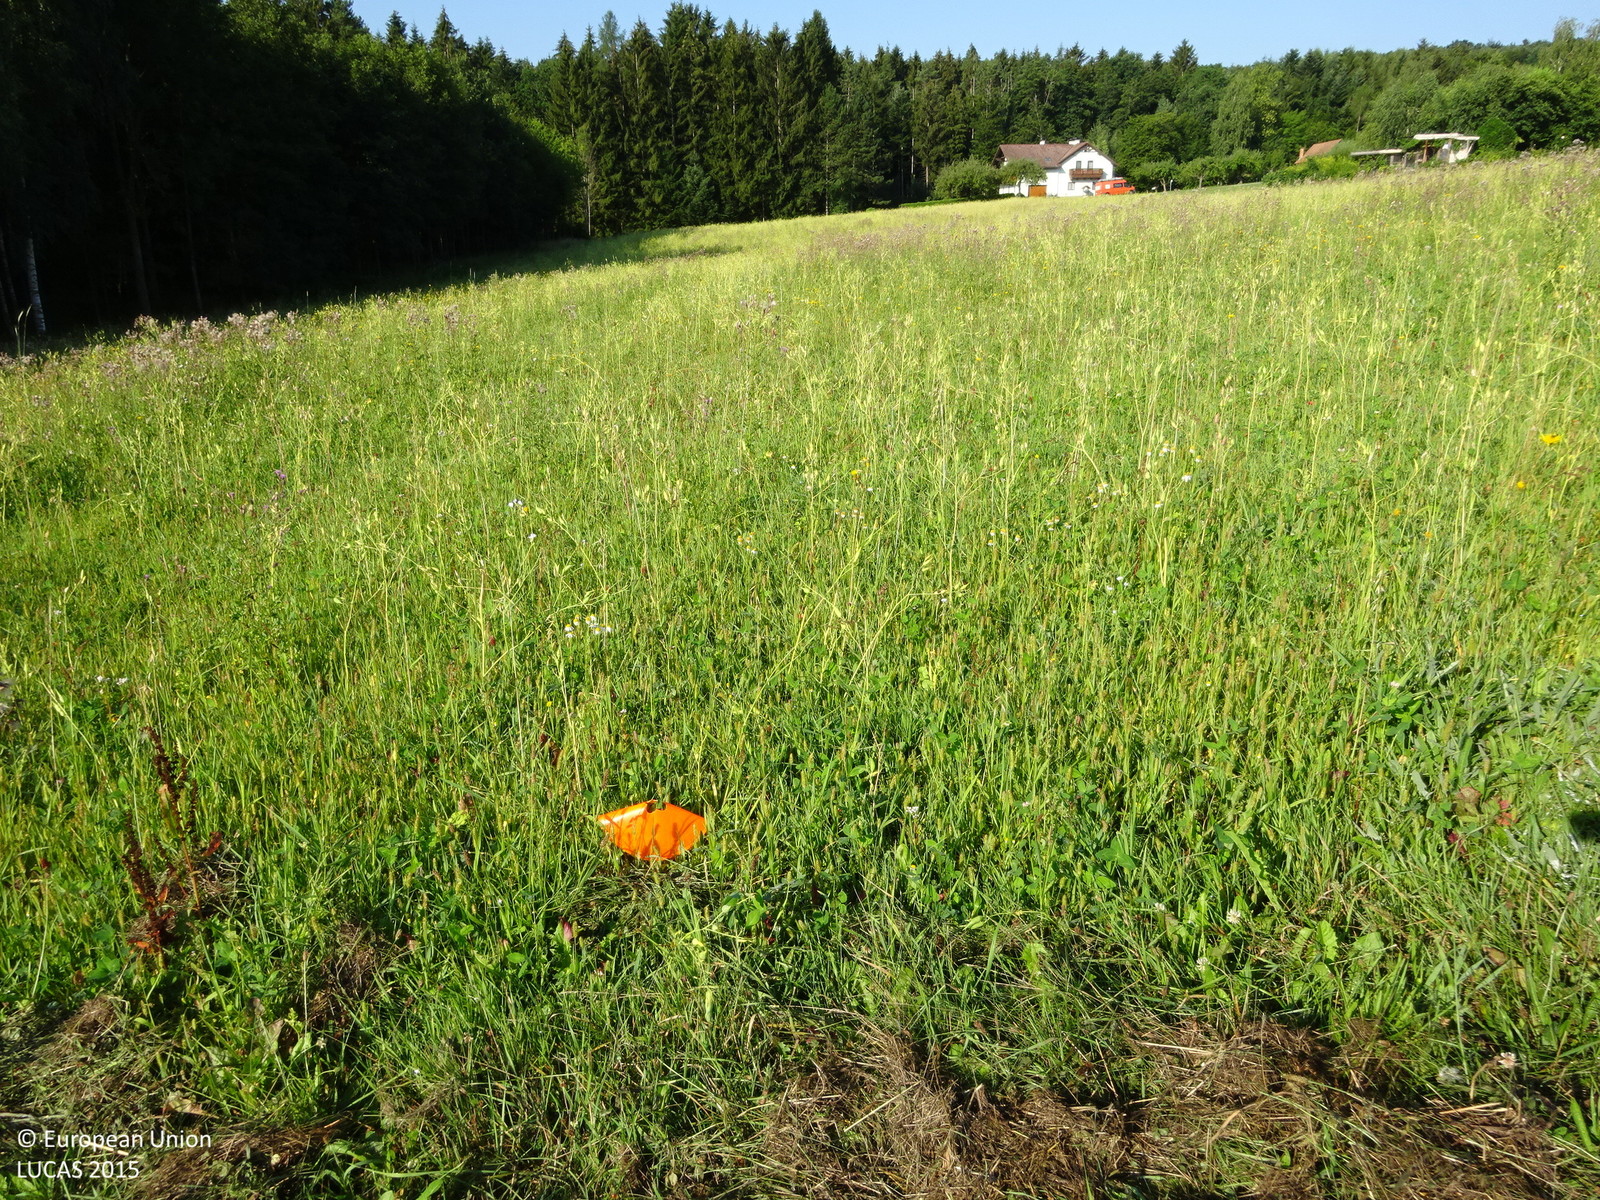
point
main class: Grassland
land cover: Grassland without tree/shrub cover
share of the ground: > 75 %
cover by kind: herbaceous plants 100 %
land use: Agriculture (excluding fallow land and kitchen gardens)
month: August
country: AT
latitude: 47.3908
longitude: 16.0298
